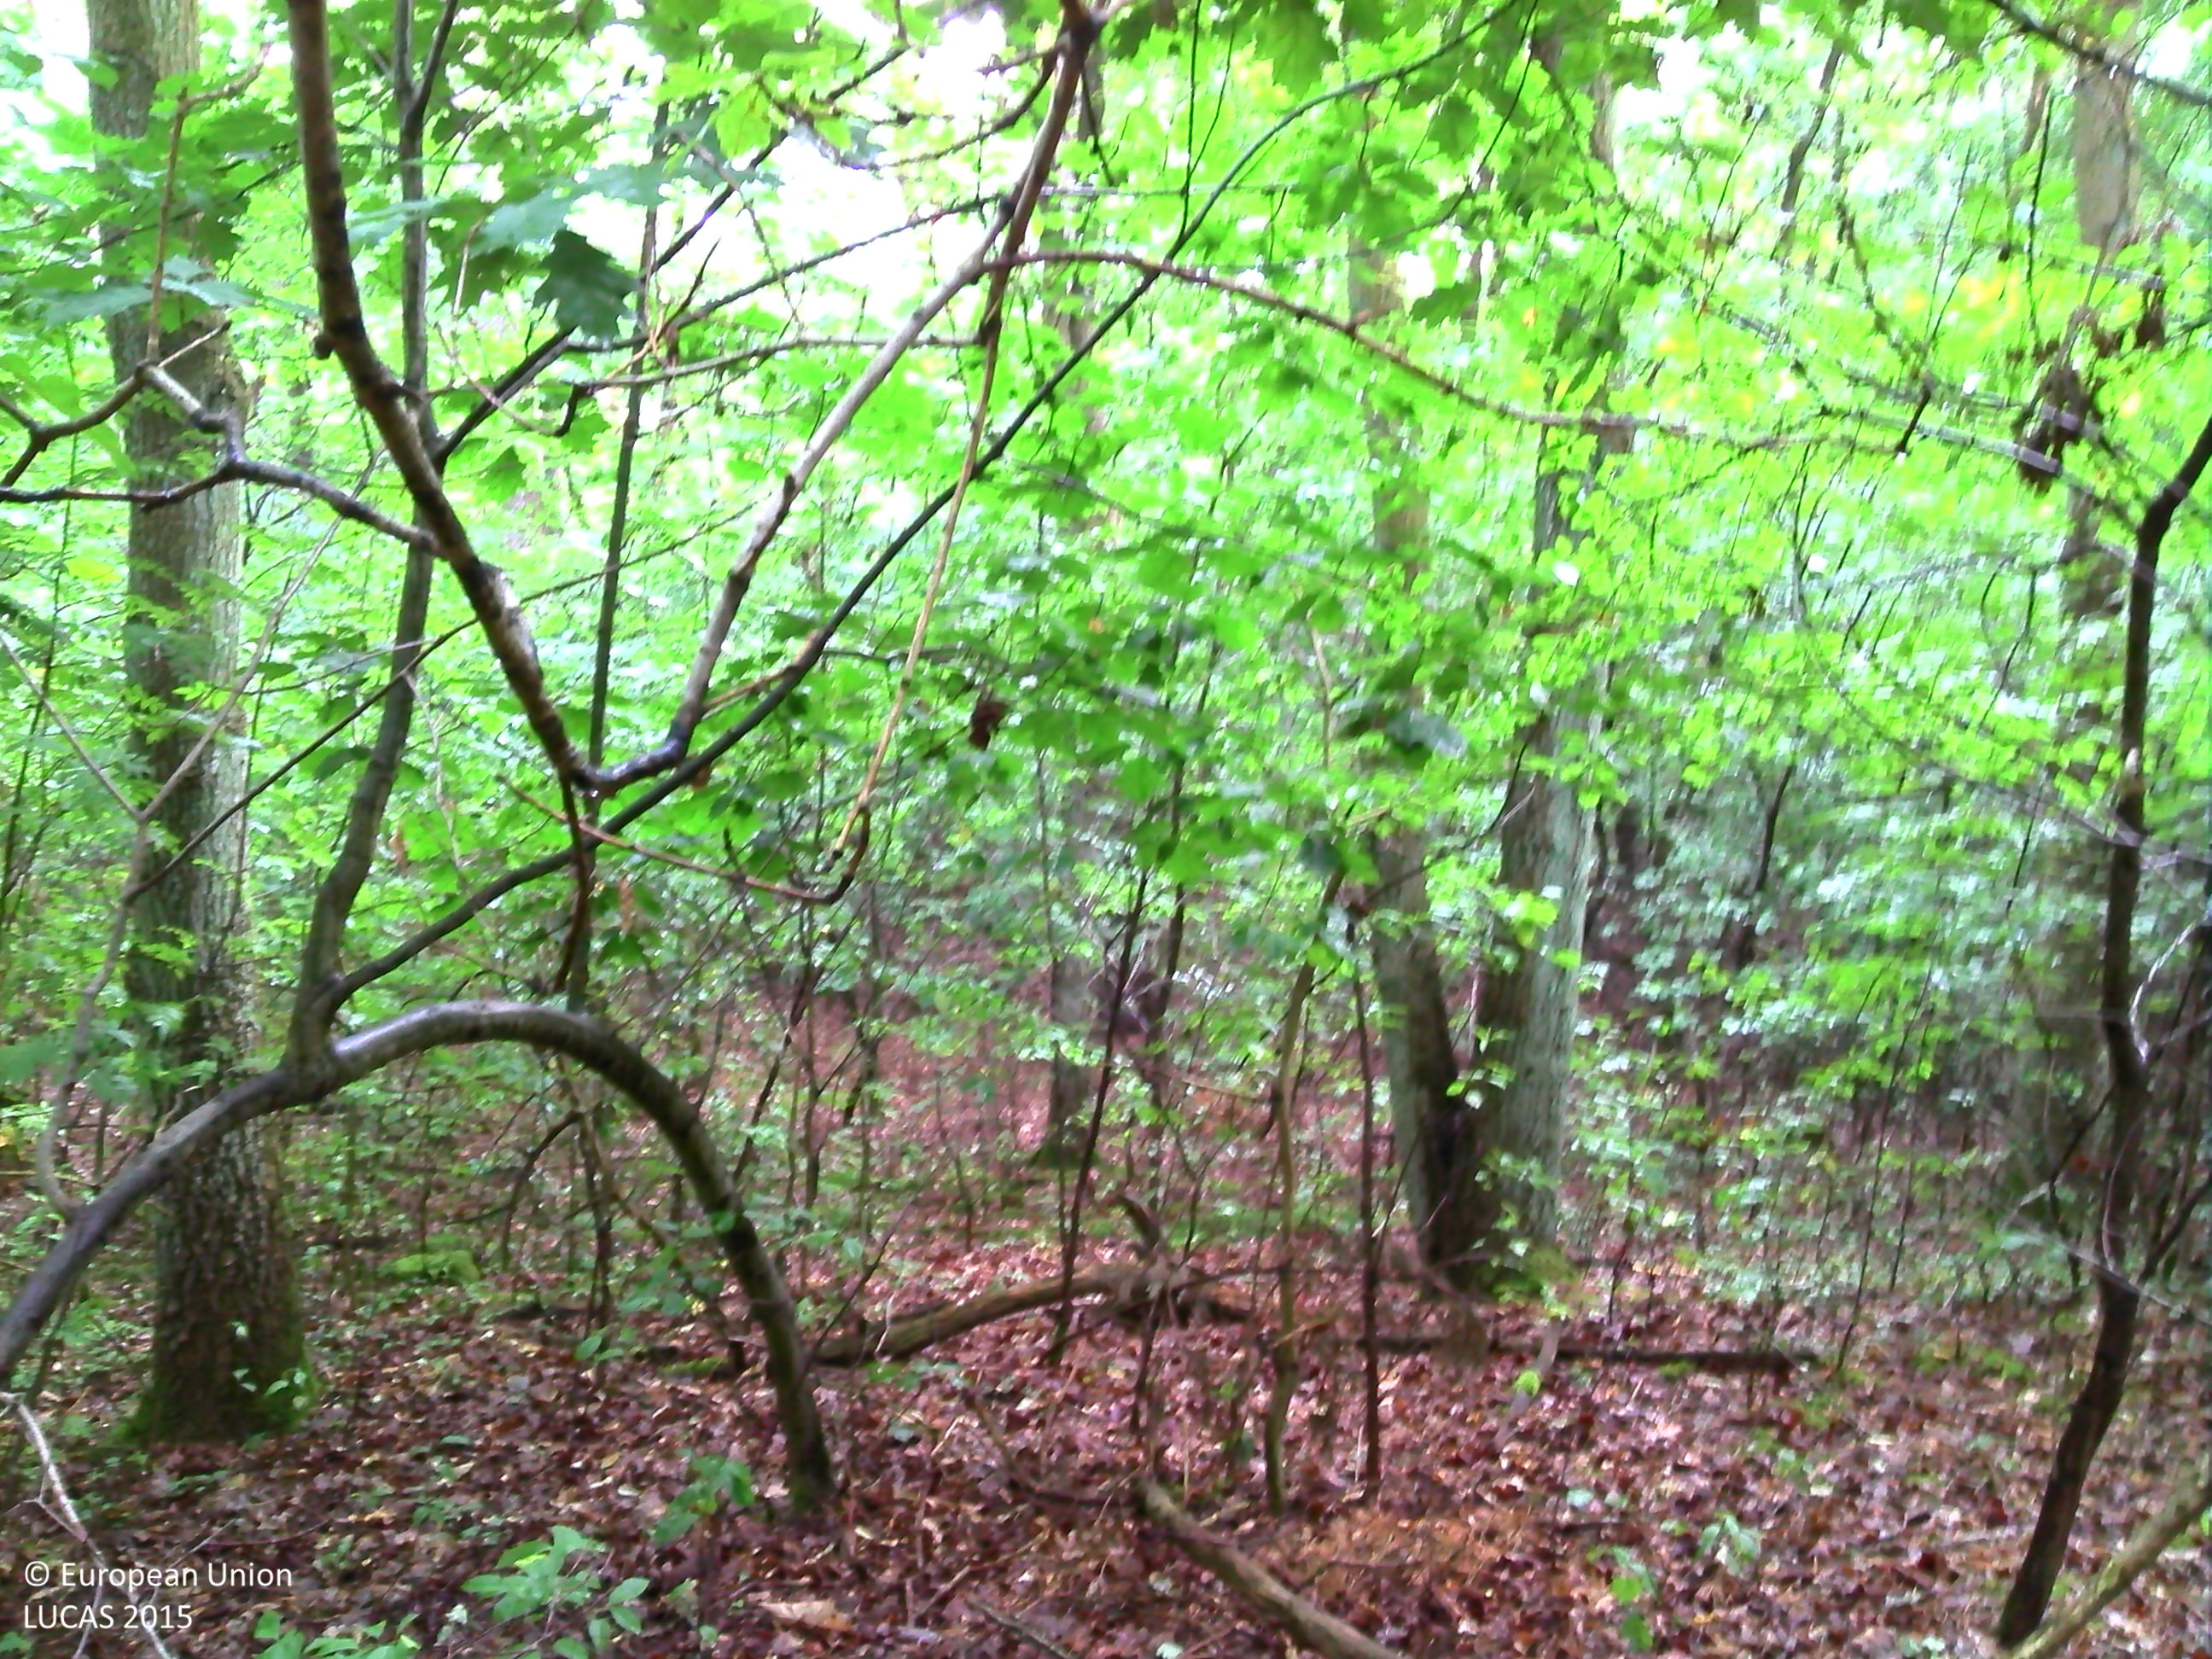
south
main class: Woodland
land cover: Pine dominated mixed woodland
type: hemiboreal forest and nemoral coniferous forest and mixed broadleaved-coniferous forest
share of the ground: > 75 %
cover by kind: coniferous forest trees 60 %, broadleaved forest trees 40 %
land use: Forestry
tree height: > 5 m
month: August
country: BE
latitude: 50.9425
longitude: 5.5151
